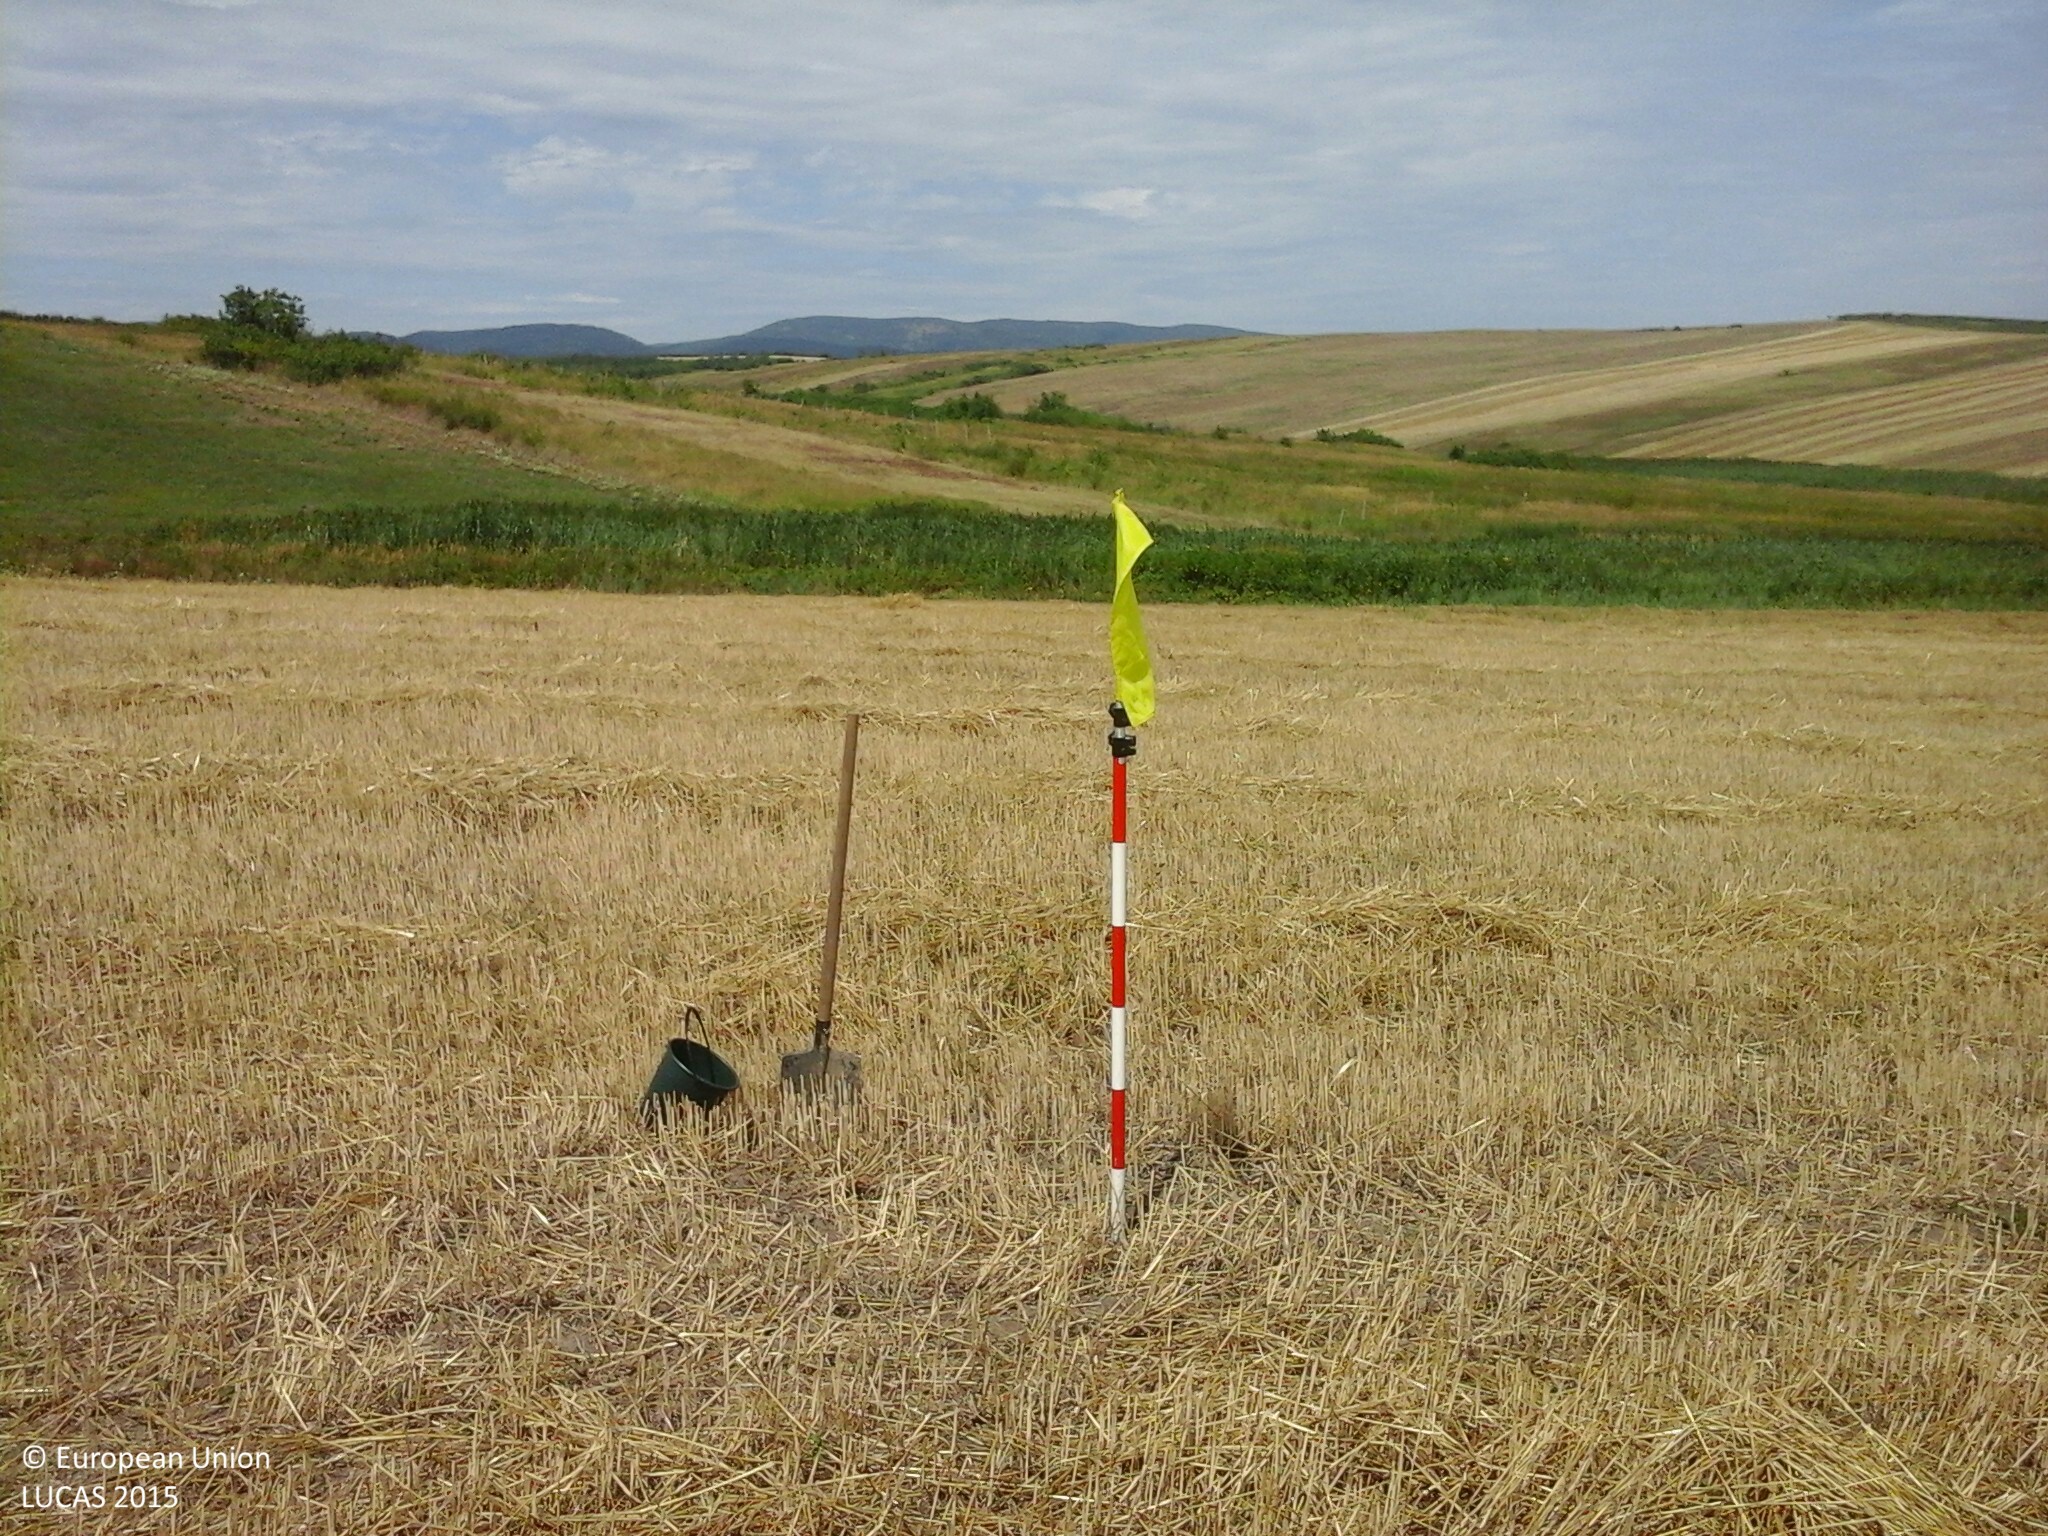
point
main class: Cropland
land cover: Common wheat
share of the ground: 50 - 75 %
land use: Agriculture (excluding fallow land and kitchen gardens)
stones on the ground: < 10 %
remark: Harvested field
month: July
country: HU
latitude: 47.9420
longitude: 20.6509
